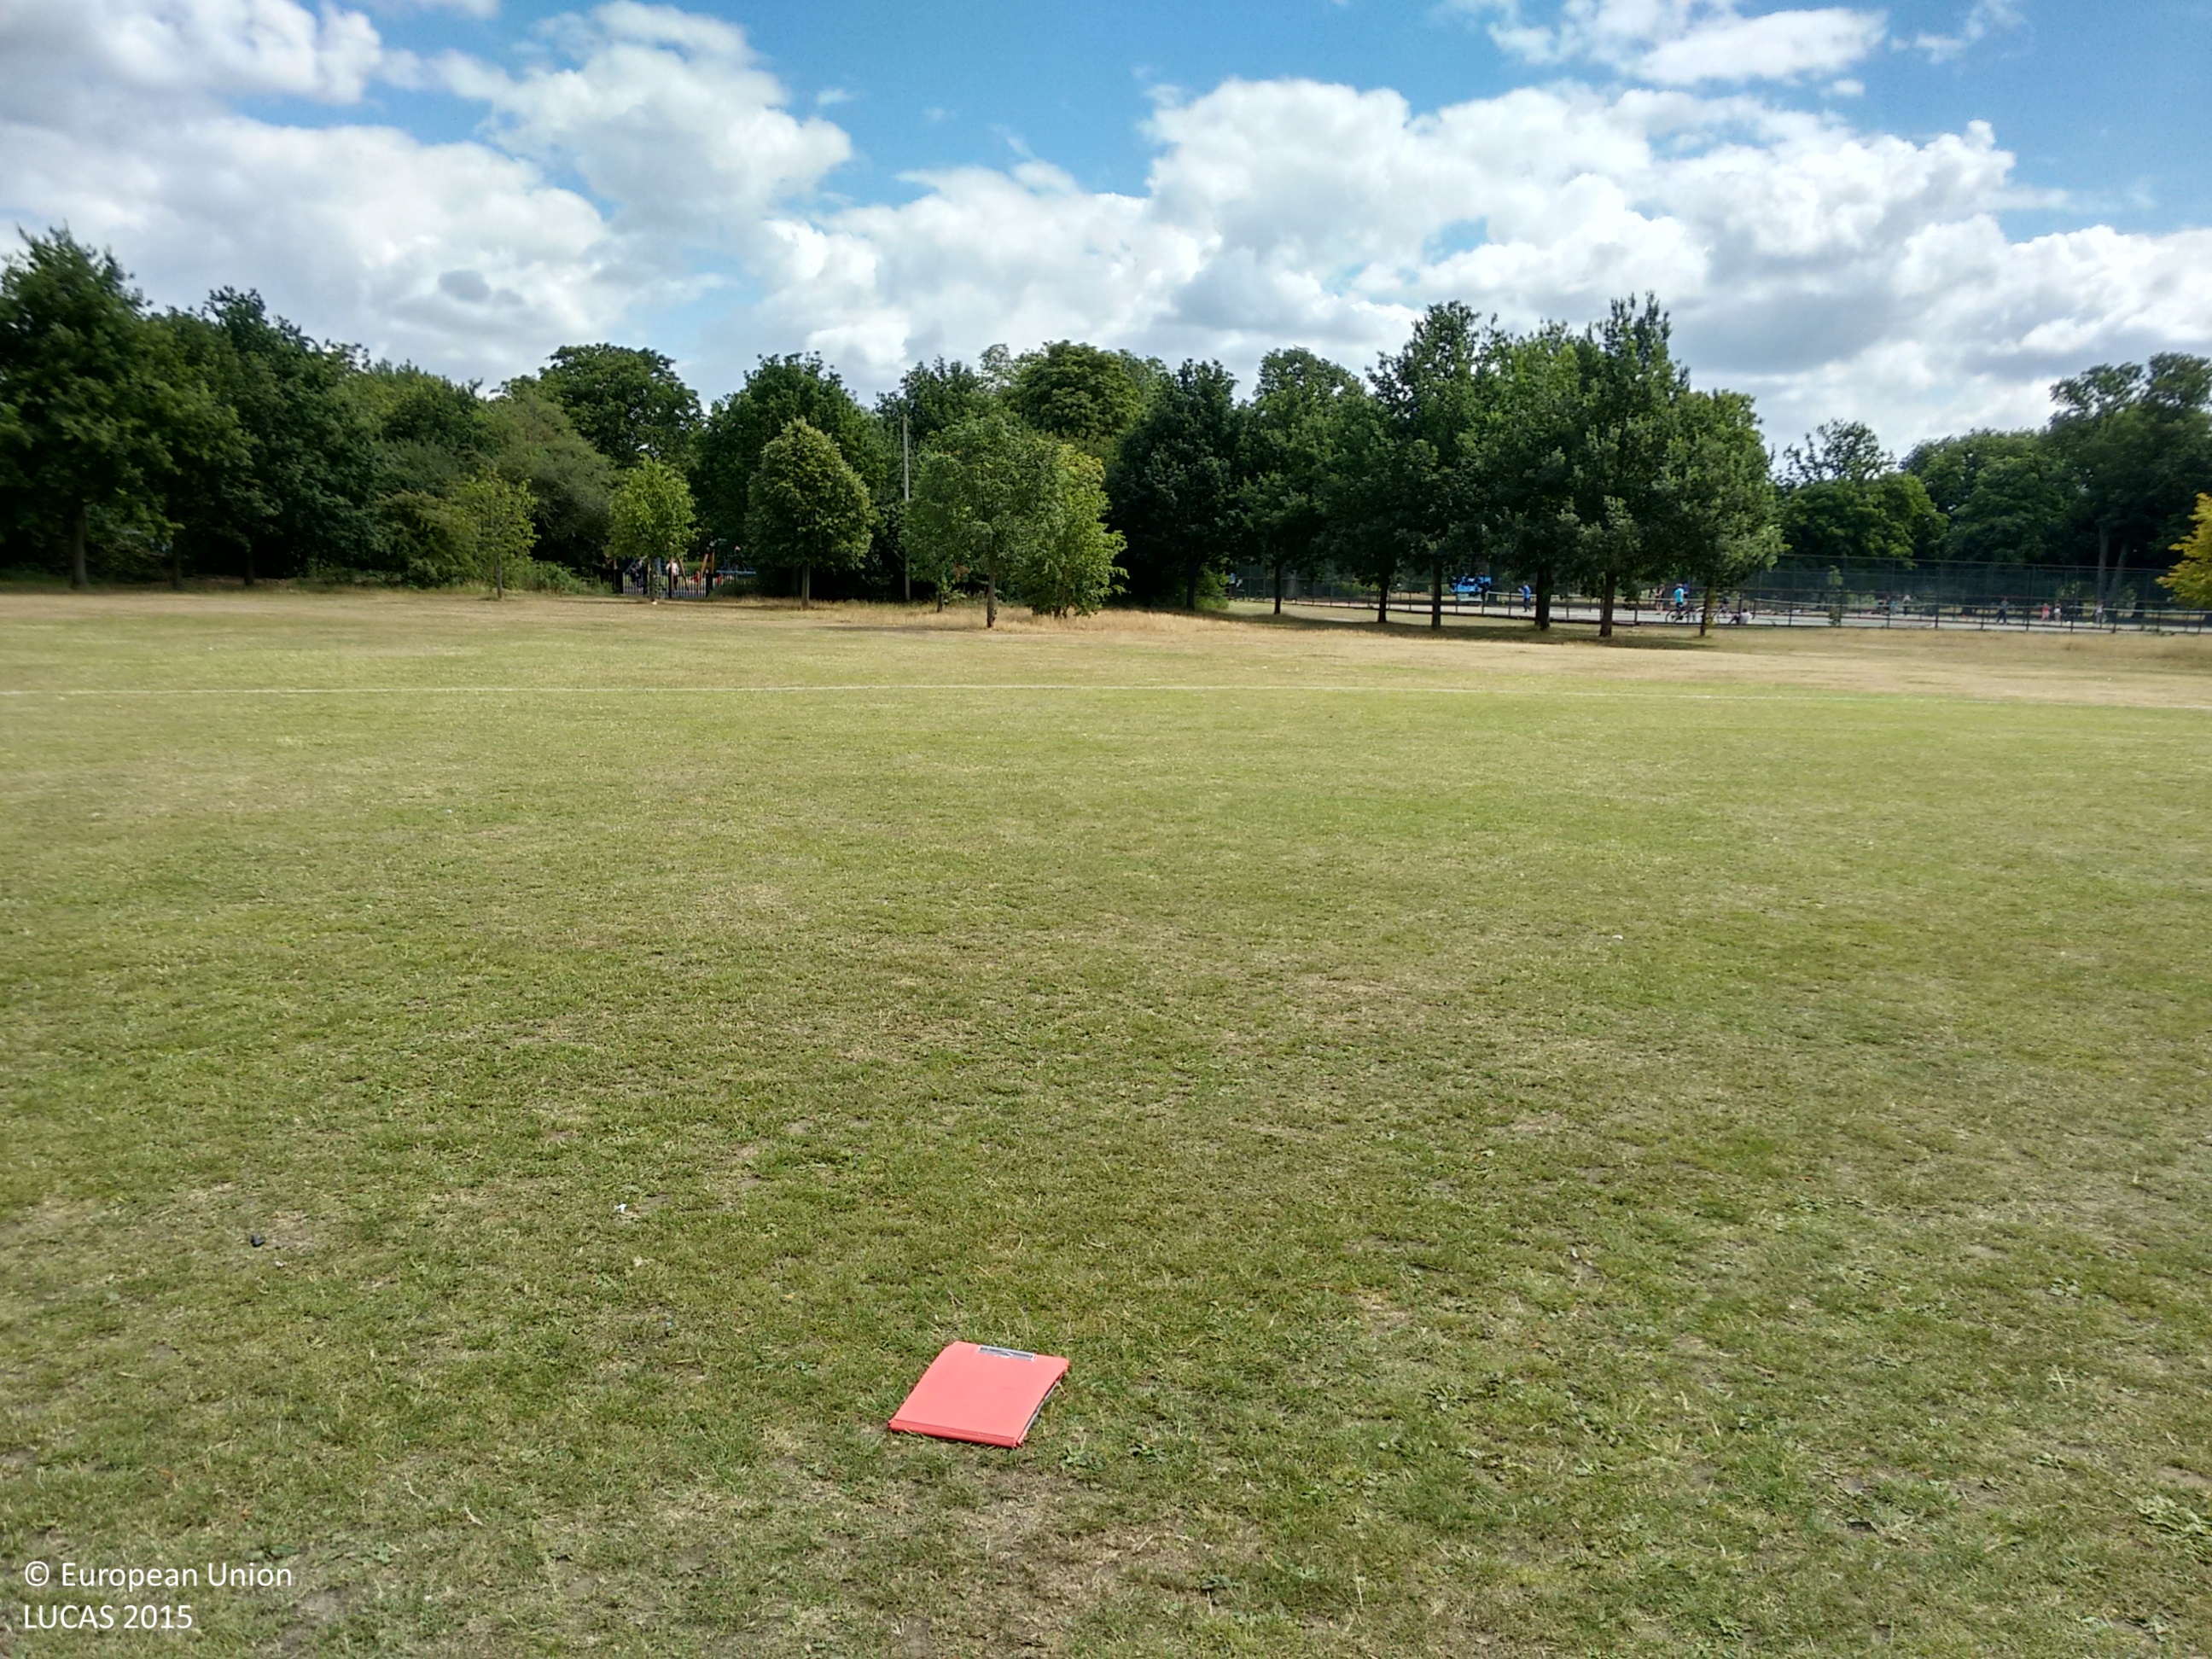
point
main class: Grassland
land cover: Grassland without tree/shrub cover
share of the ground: > 75 %
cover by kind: herbaceous plants 100 %
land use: Amenities, museums, leisure
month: July
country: GB
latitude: 51.4341
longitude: -0.1469
